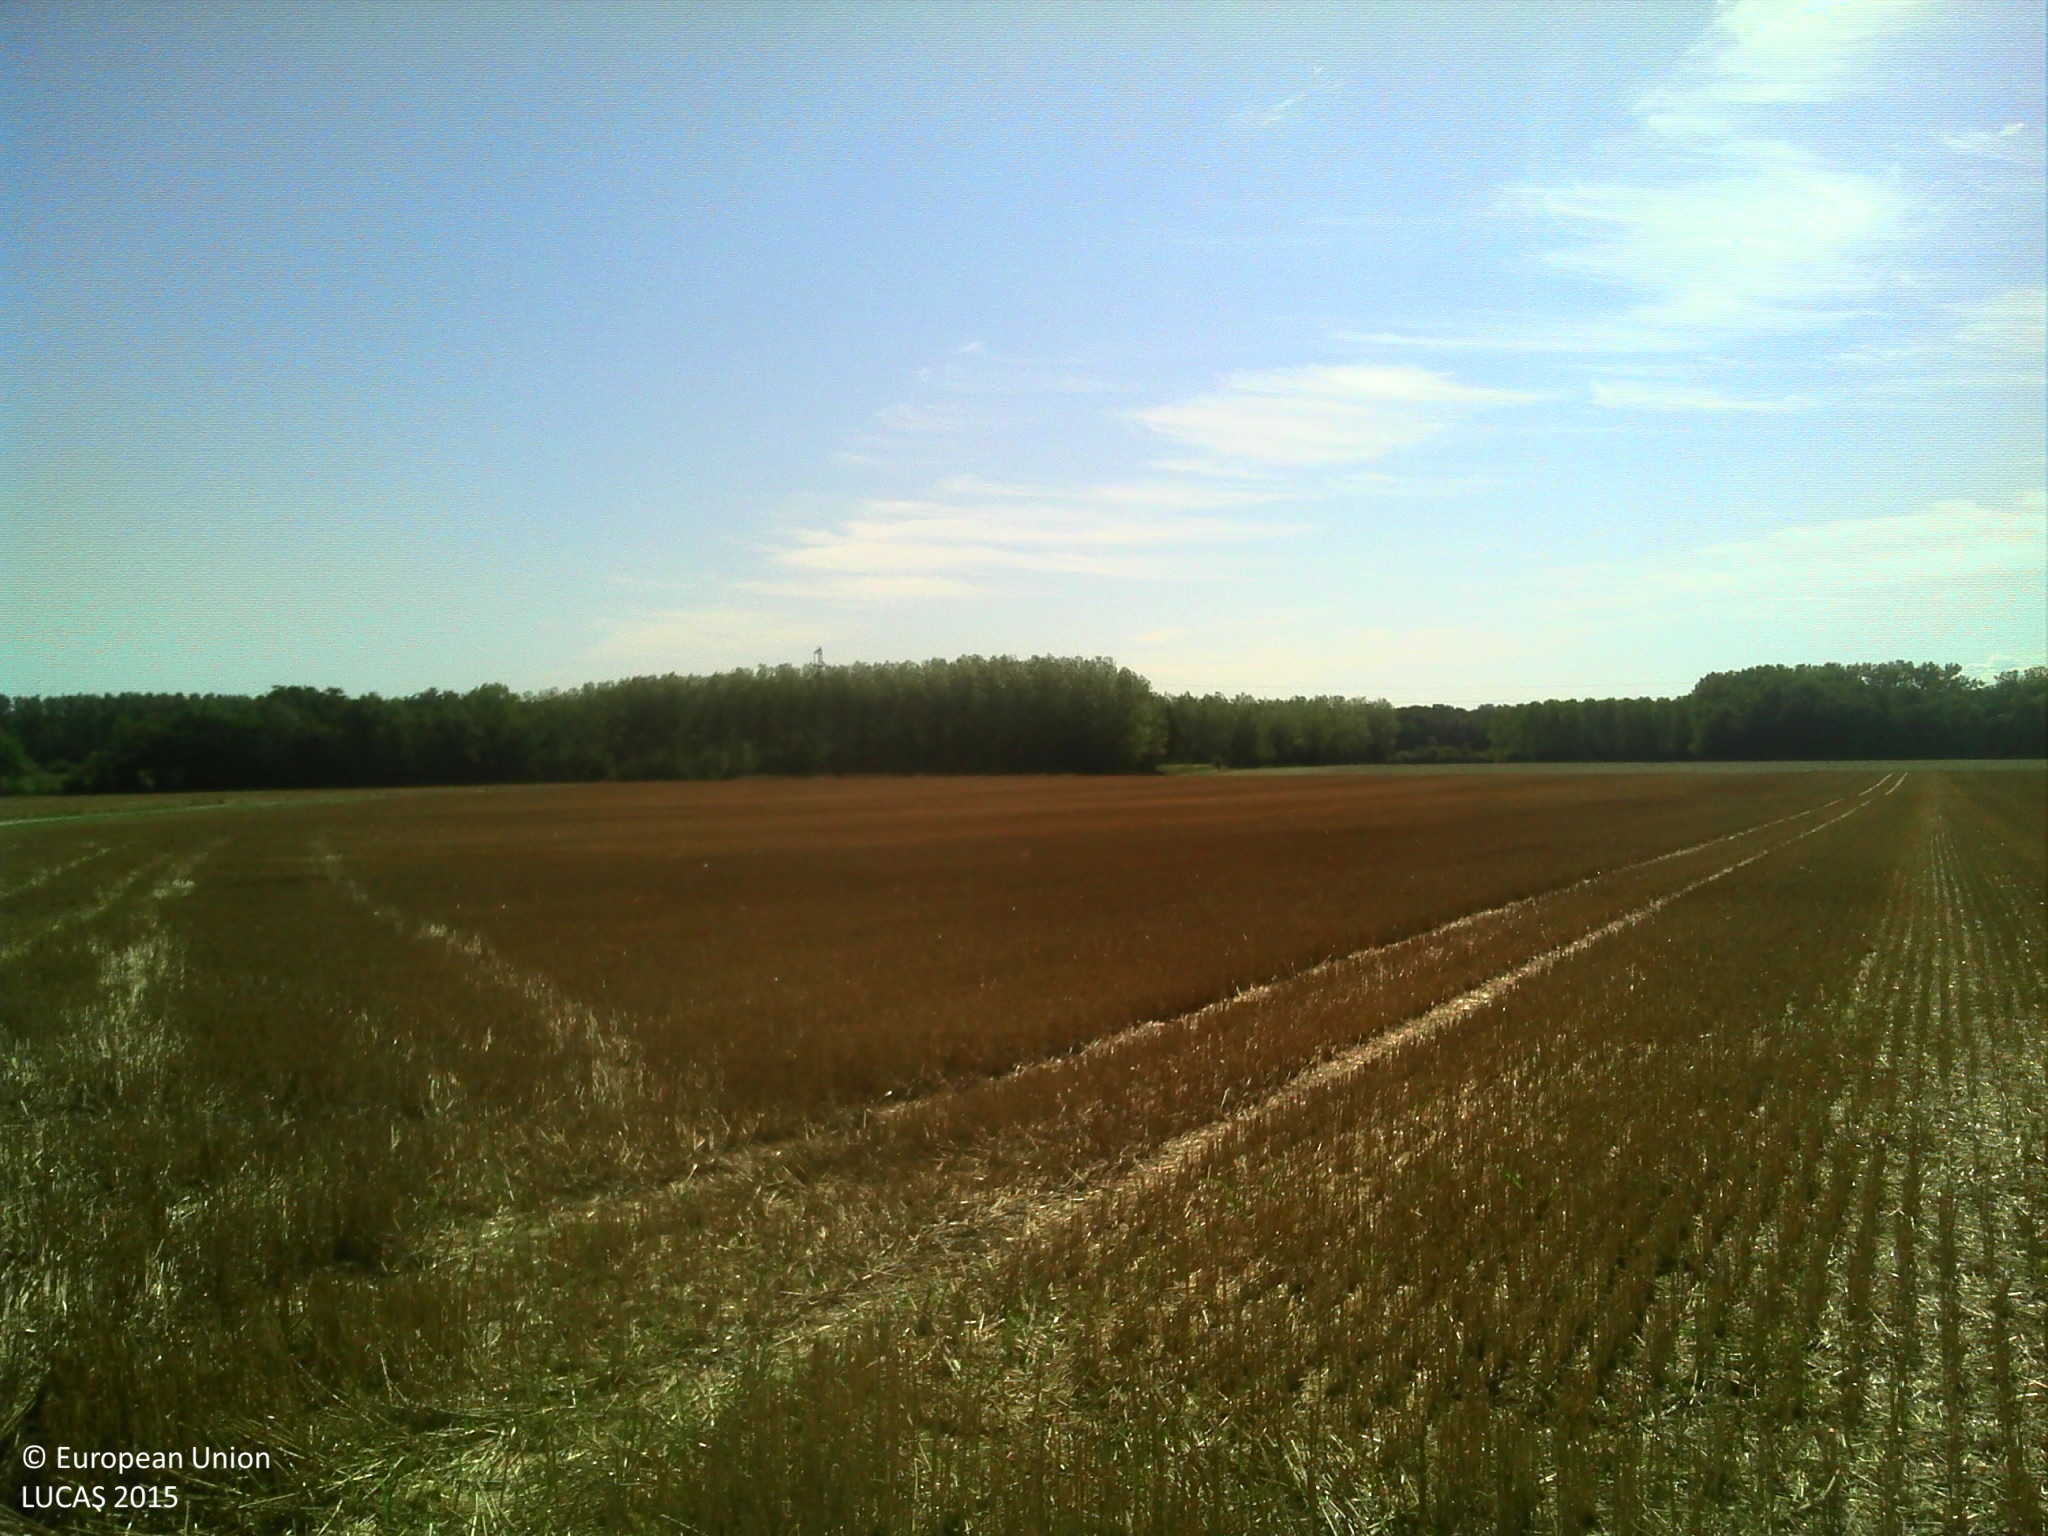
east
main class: Cropland
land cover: Common wheat
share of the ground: > 75 %
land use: Agriculture (excluding fallow land and kitchen gardens)
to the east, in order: Common wheat
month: July
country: FR
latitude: 46.7725
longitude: 4.9334
